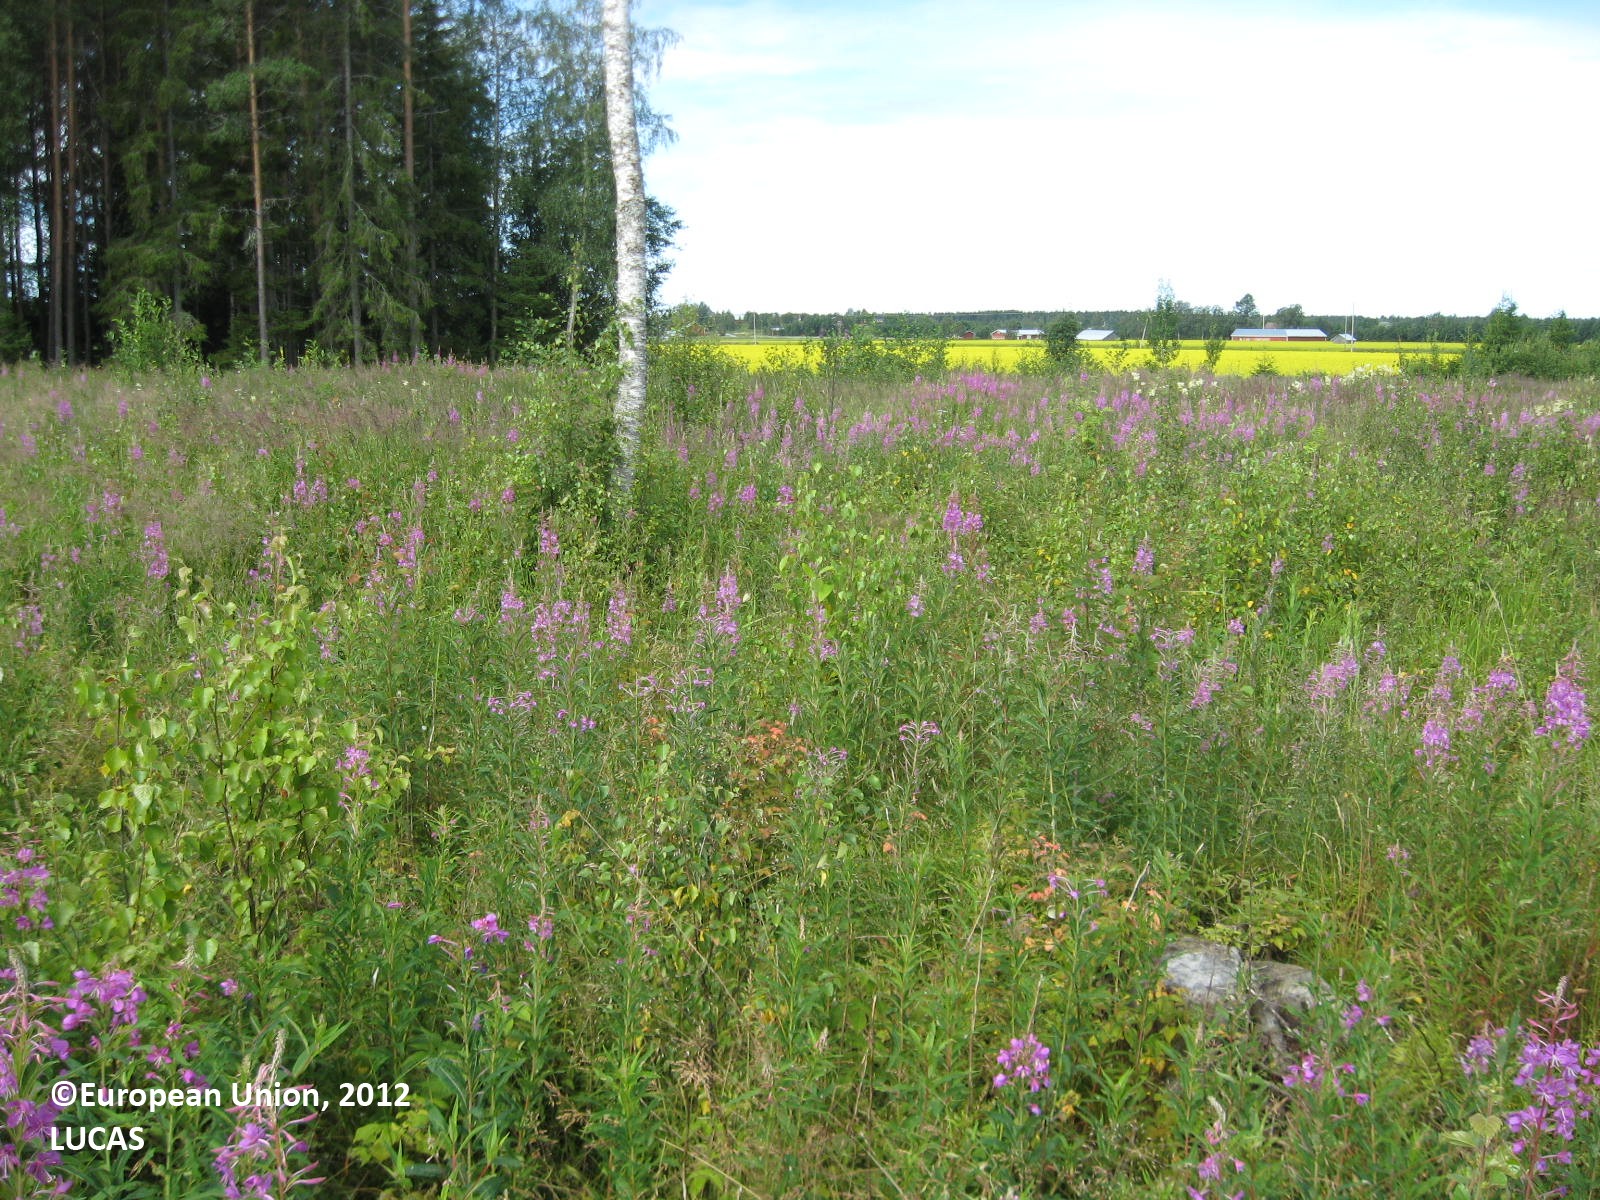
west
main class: Woodland
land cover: Broadleaved woodland
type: boreal forest
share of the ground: 10 - 25 %
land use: Forestry
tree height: < 5 m
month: July
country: FI
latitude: 62.2996
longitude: 21.4796
